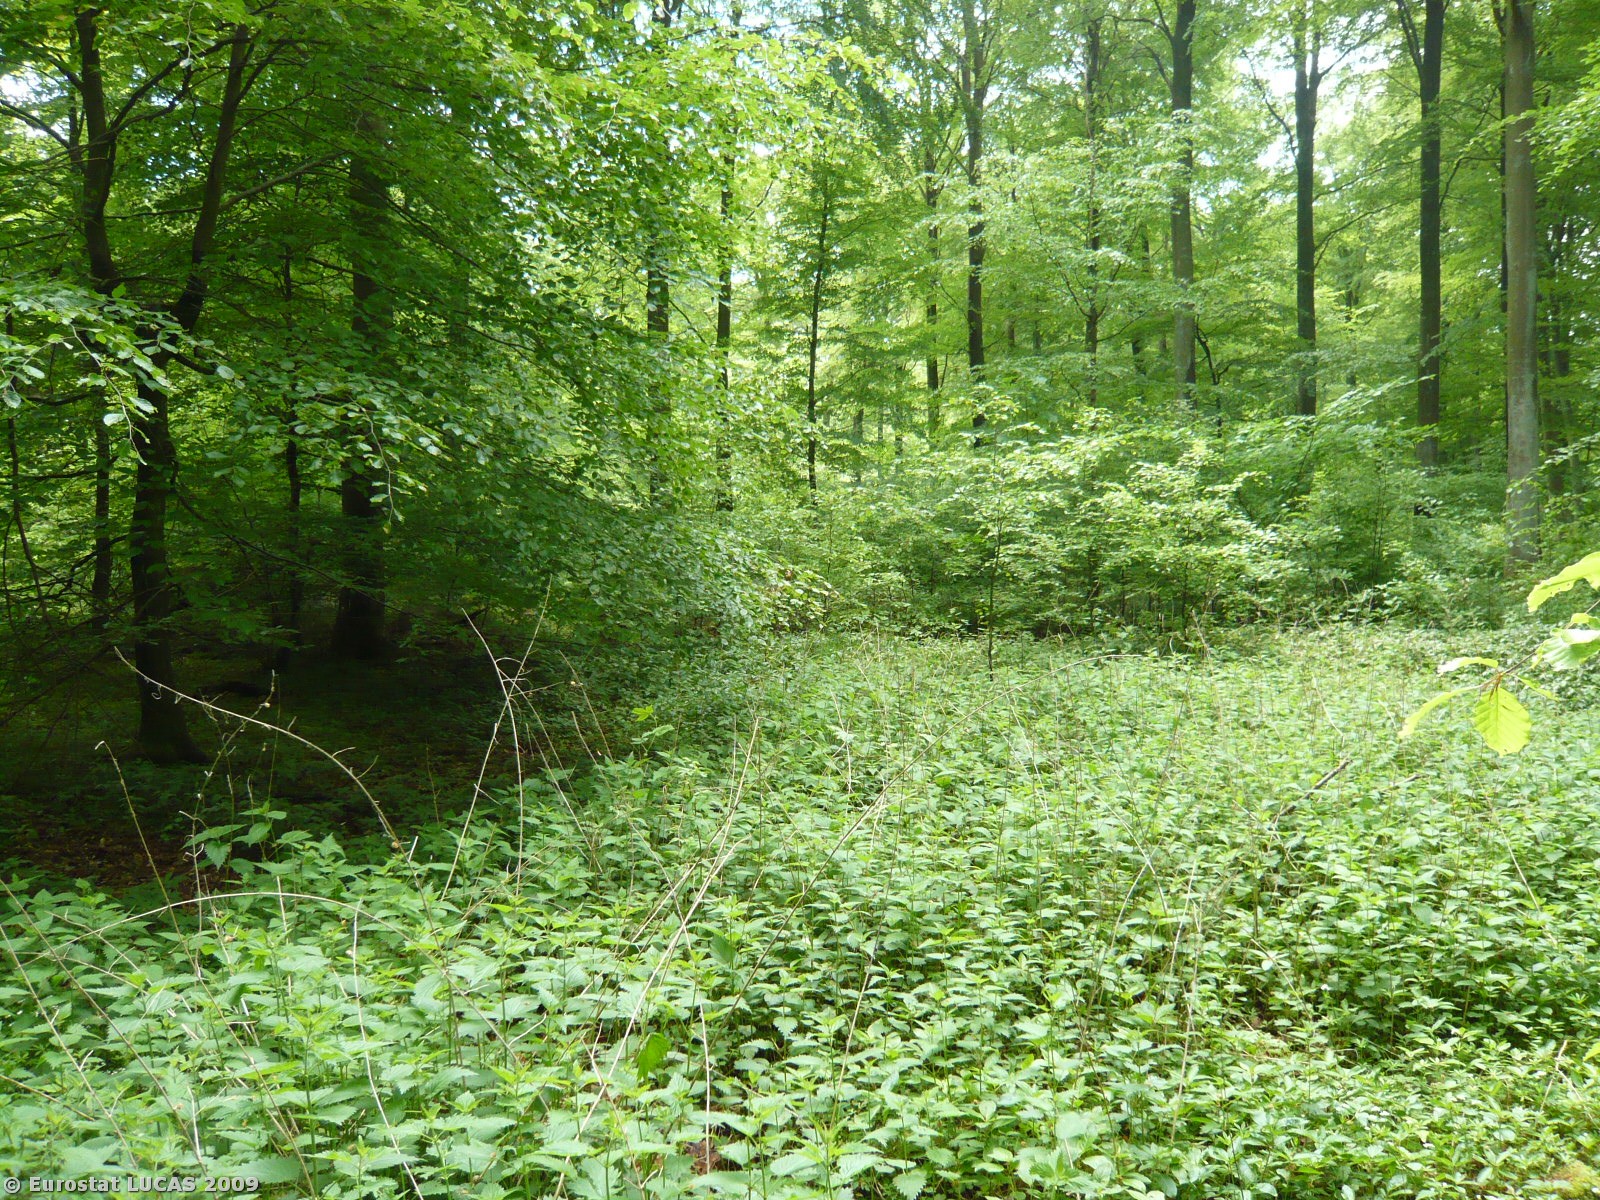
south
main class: Woodland
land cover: Broadleaved woodland
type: mesophytic deciduous forest
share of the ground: > 75 %
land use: Forestry
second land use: Amenities, museums, leisure
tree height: > 5 m
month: May
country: DK
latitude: 55.4228
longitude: 11.5944
